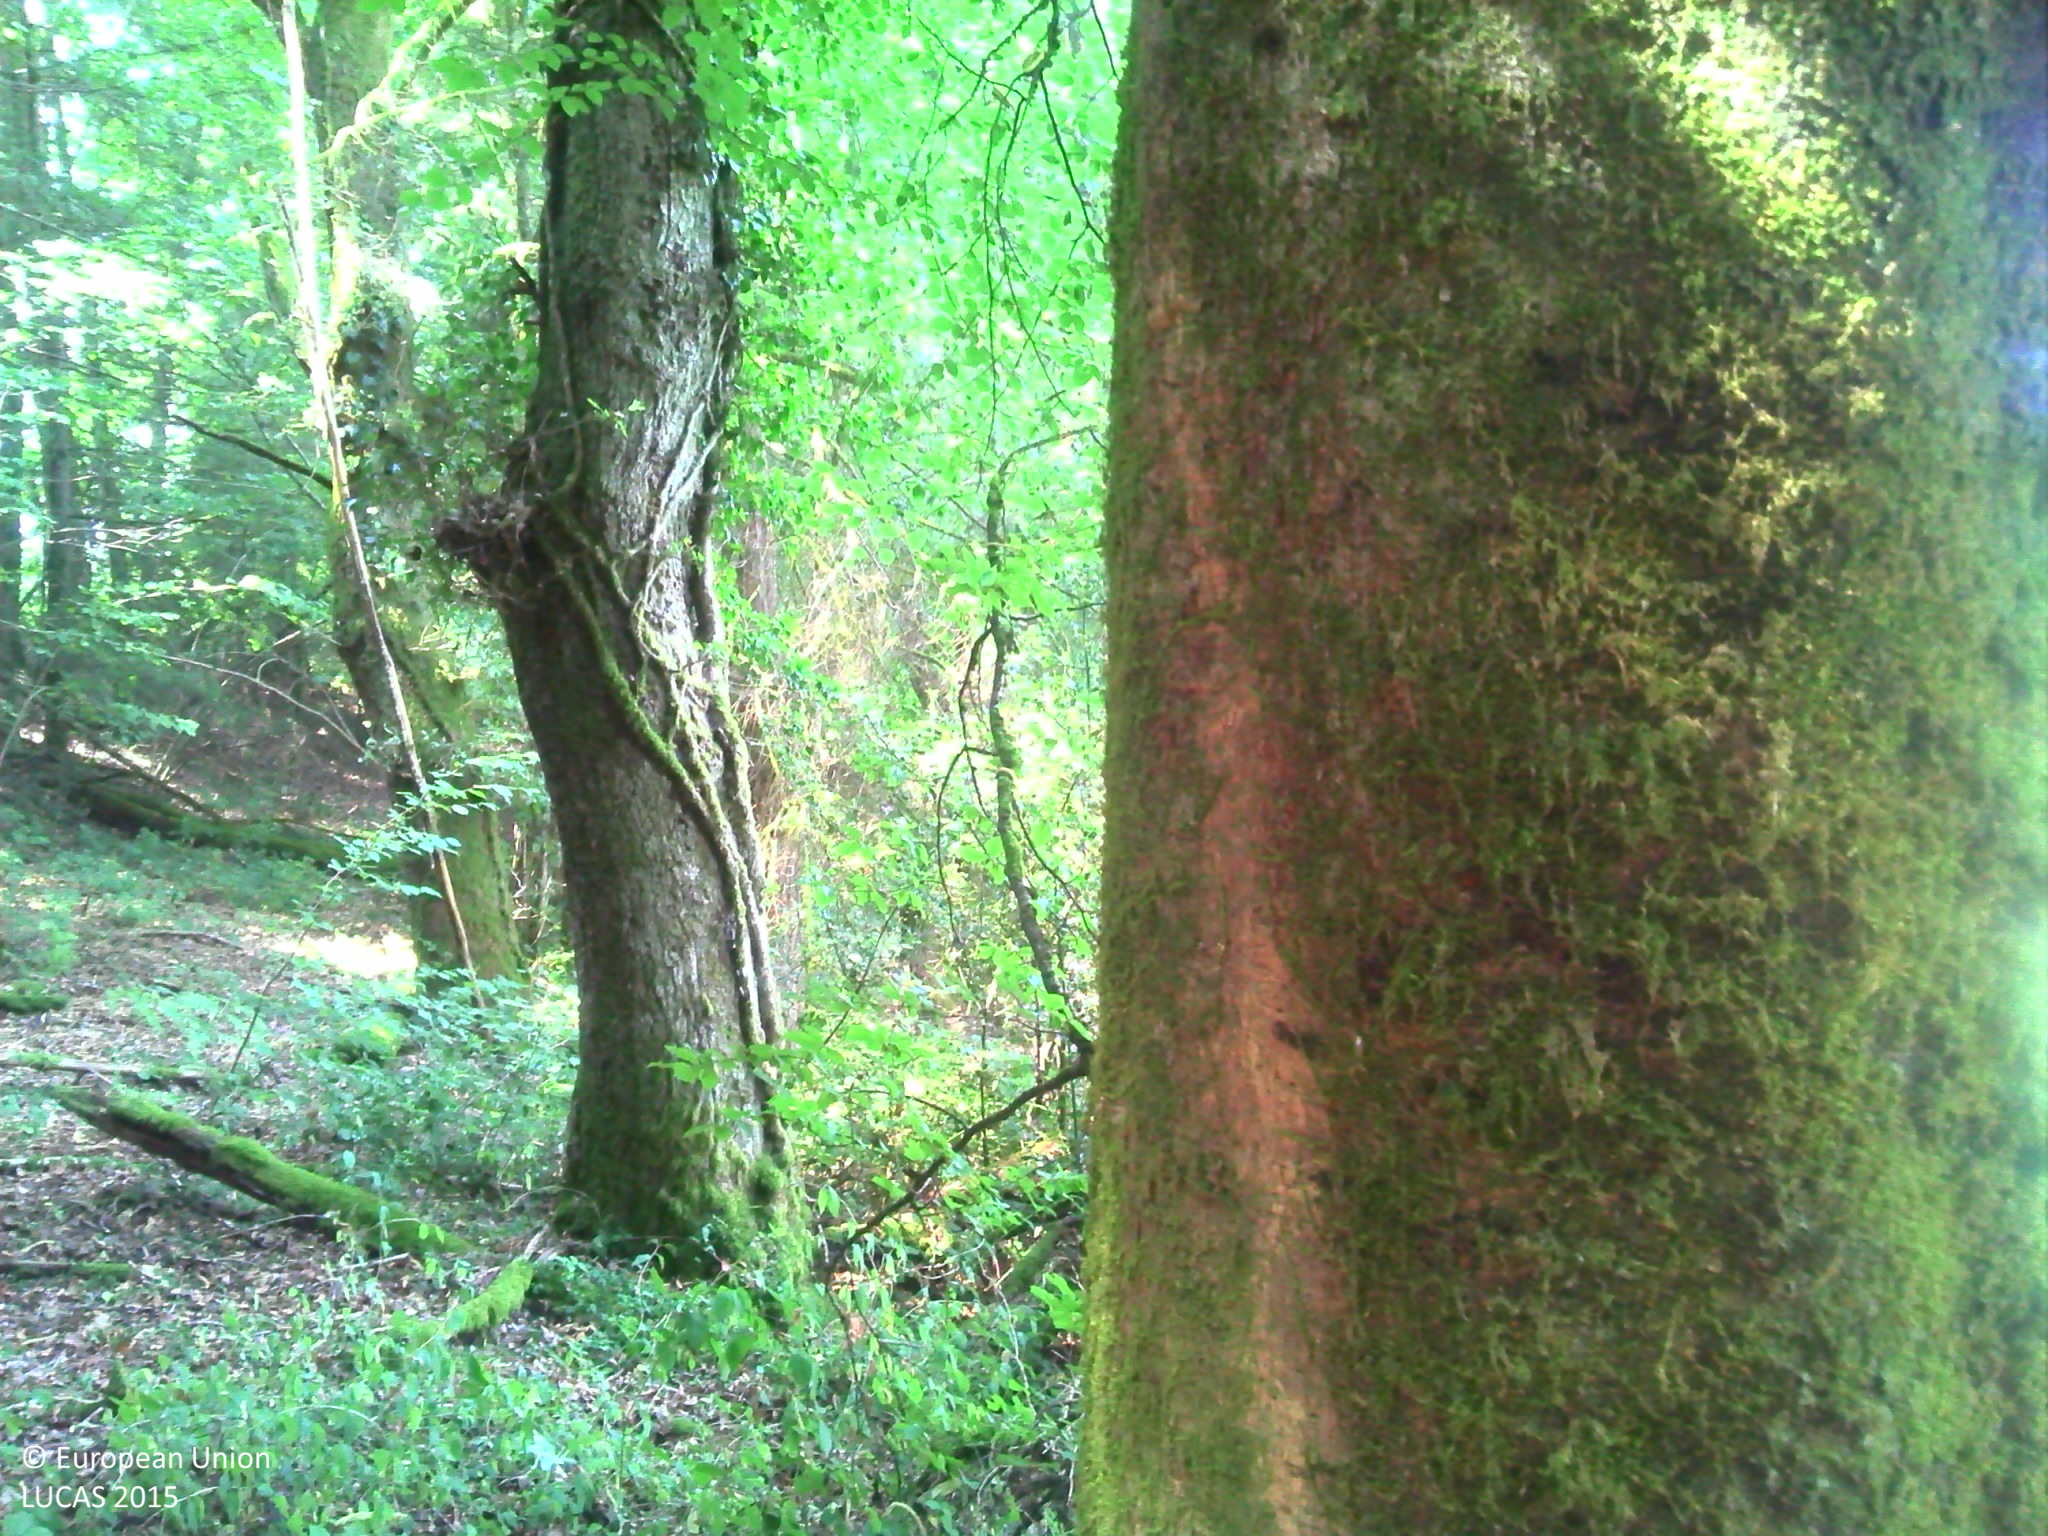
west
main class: Woodland
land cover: Spruce dominated mixed woodland
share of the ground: > 75 %
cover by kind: coniferous forest trees 45 %, broadleaved forest trees 40 %, shrubs 5 %, herbaceous plants 5 %, lichens and mosses 5 %
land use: Forestry
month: July
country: FR
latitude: 45.9457
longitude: 1.8021
